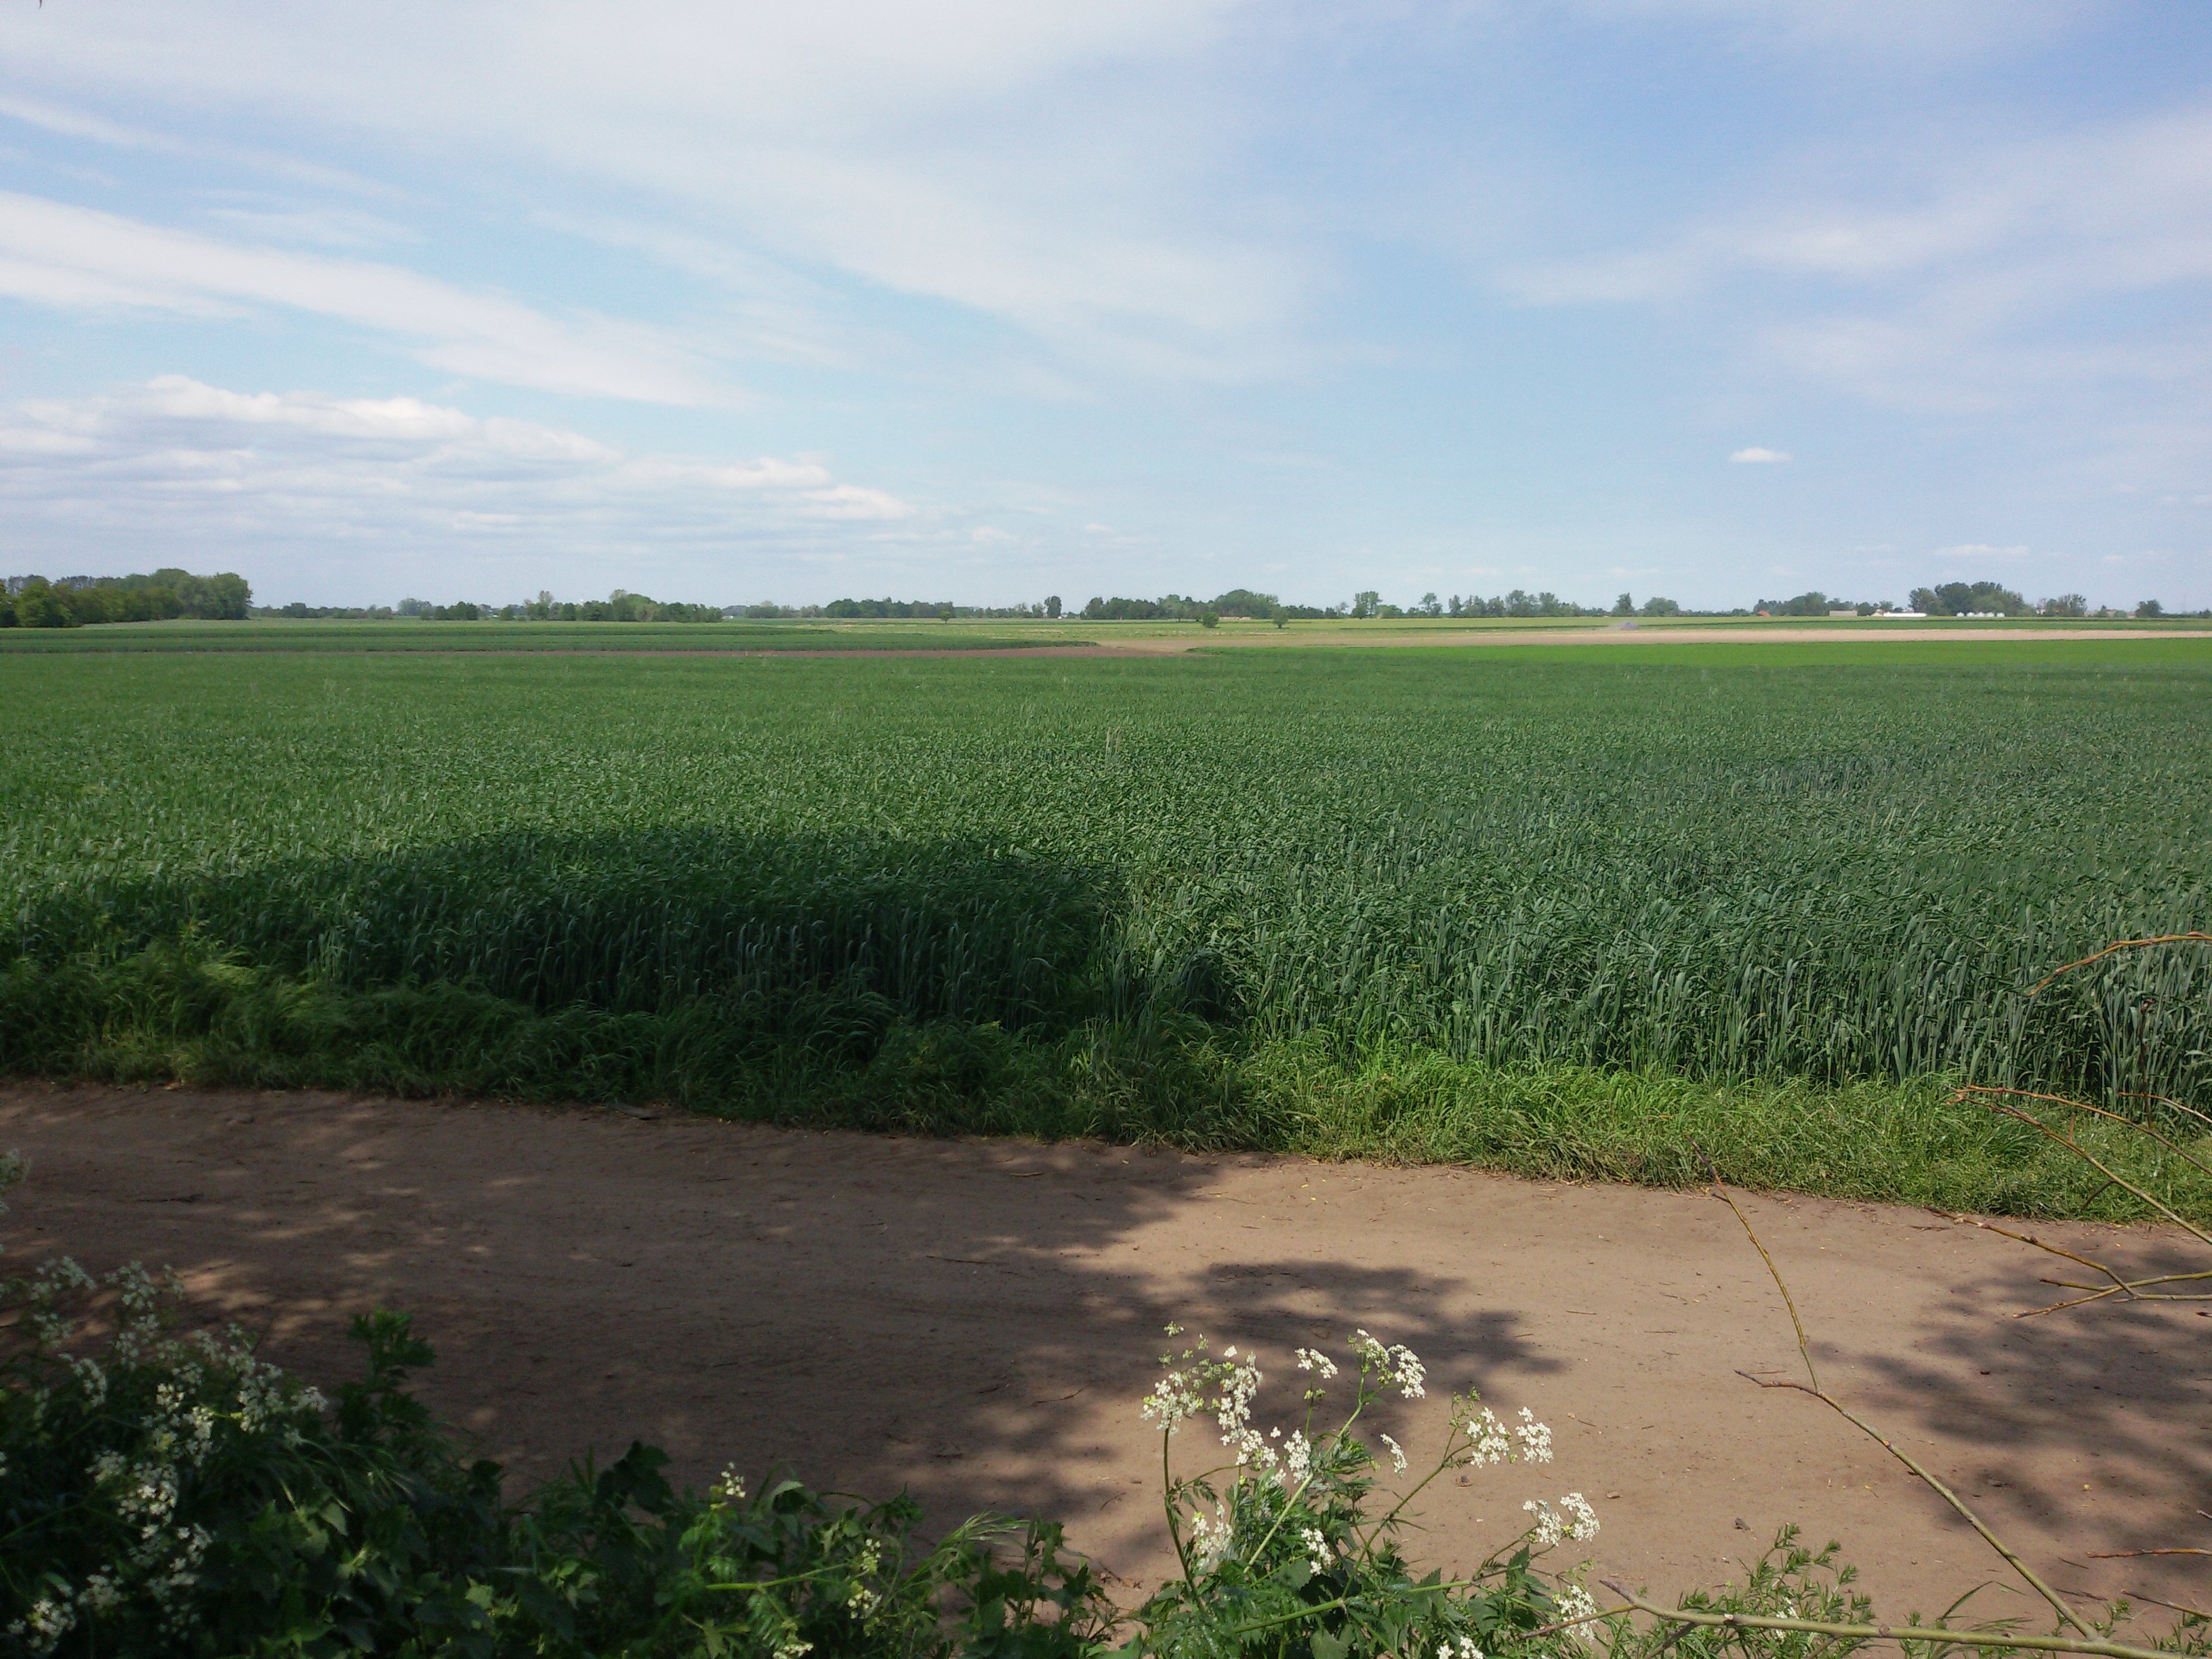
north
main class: Cropland
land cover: Potatoes
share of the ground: > 75 %
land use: Agriculture (excluding fallow land and kitchen gardens)
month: May
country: PL
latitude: 52.2166
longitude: 17.1387
